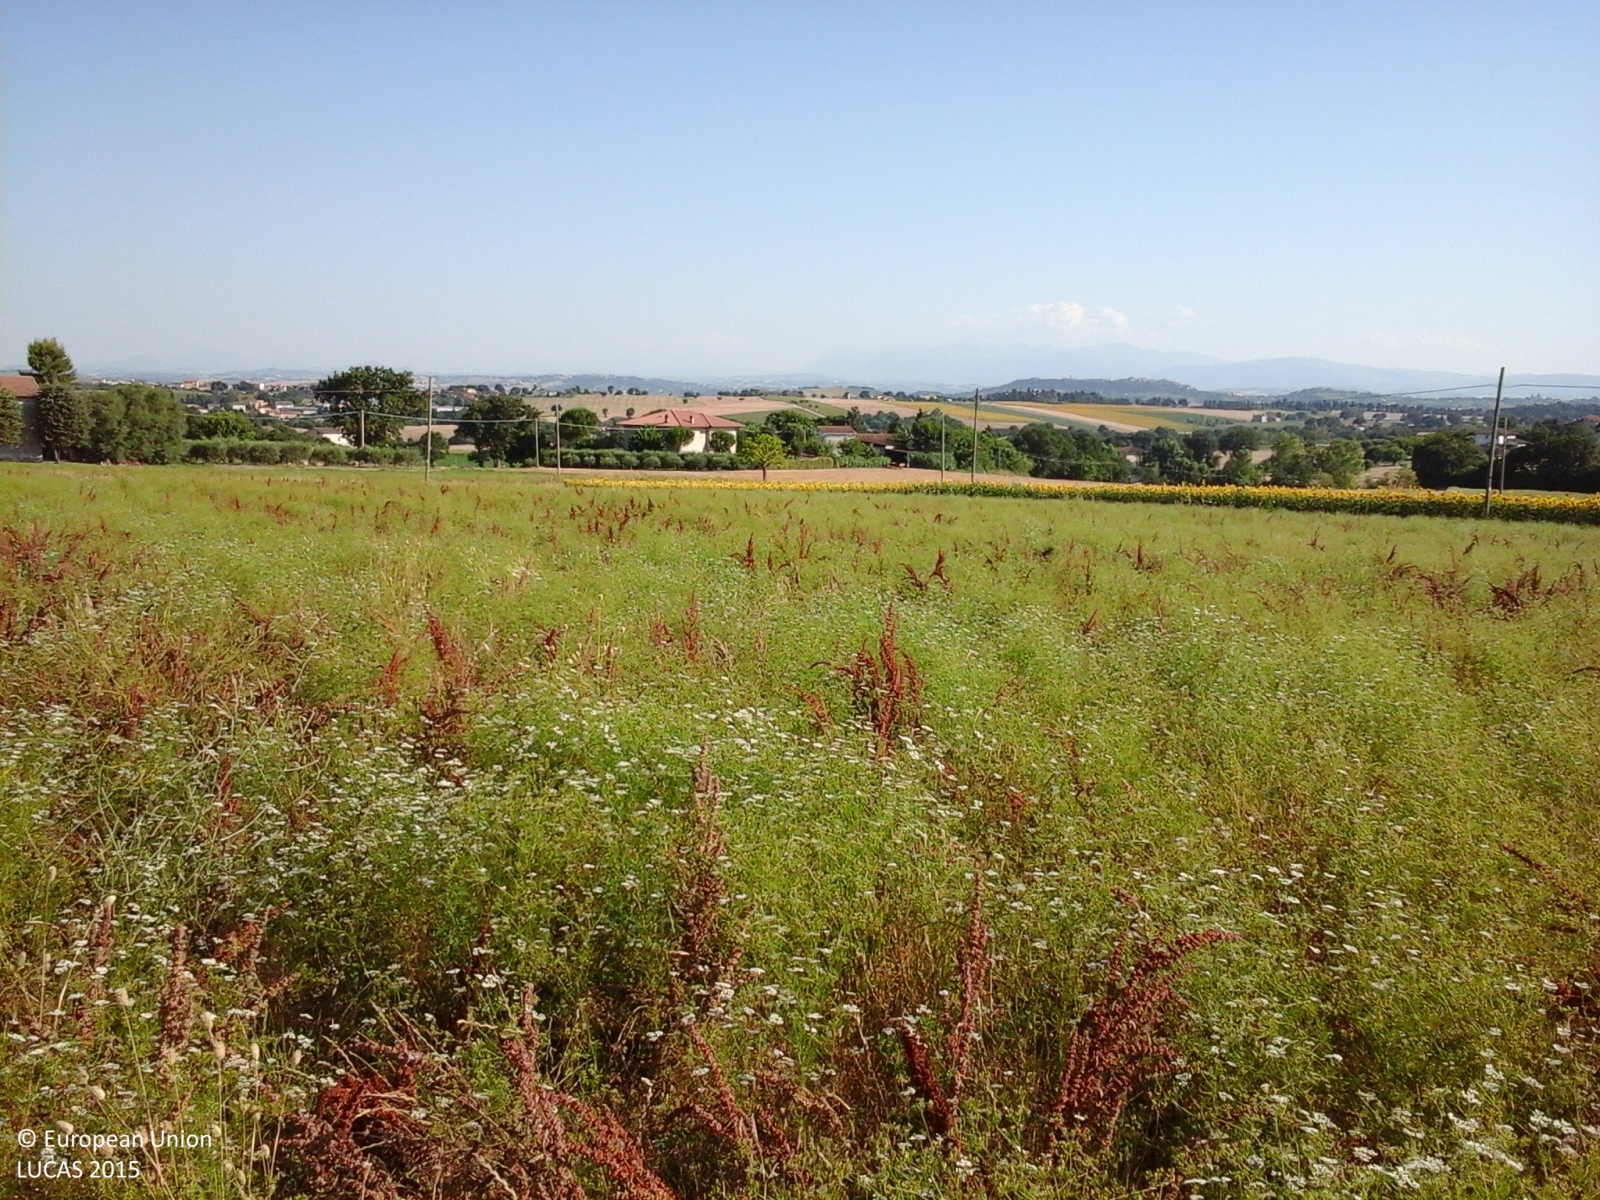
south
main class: Cropland
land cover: Other non-permanent industrial crops
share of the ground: > 75 %
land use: Agriculture (excluding fallow land and kitchen gardens)
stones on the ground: 10 - 25 %
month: July
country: IT
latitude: 43.3760
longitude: 13.3363
